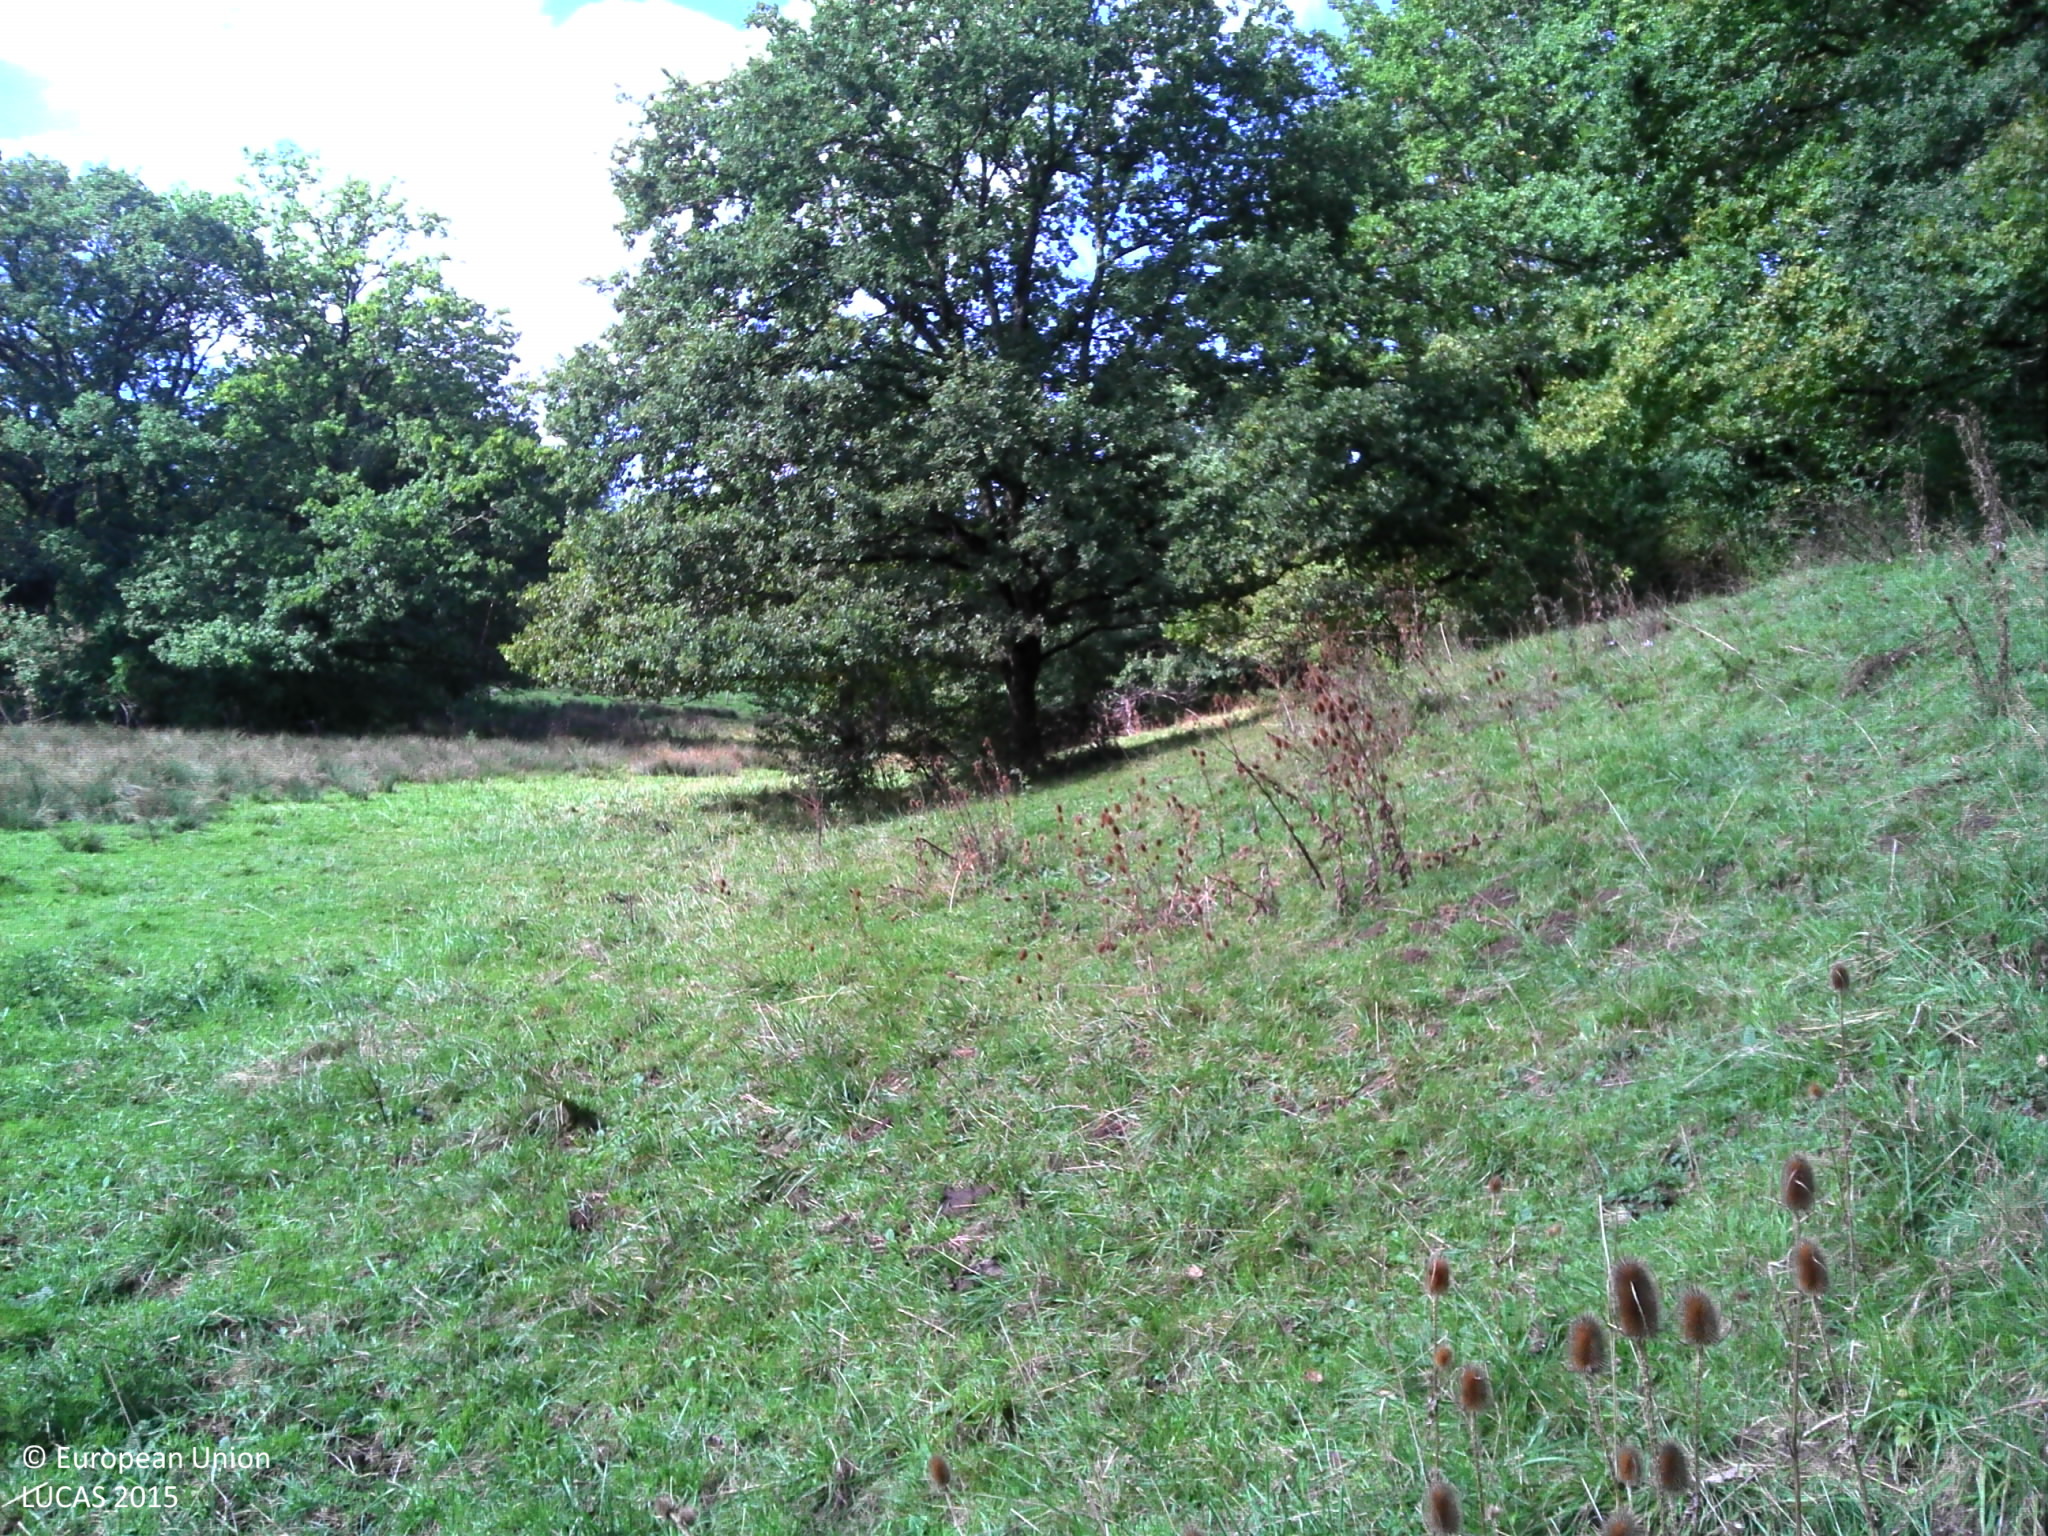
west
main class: Grassland
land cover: Grassland without tree/shrub cover
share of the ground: > 75 %
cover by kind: herbaceous plants 100 %
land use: Agriculture (excluding fallow land and kitchen gardens)
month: September
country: FR
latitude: 47.1335
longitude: 6.2710
